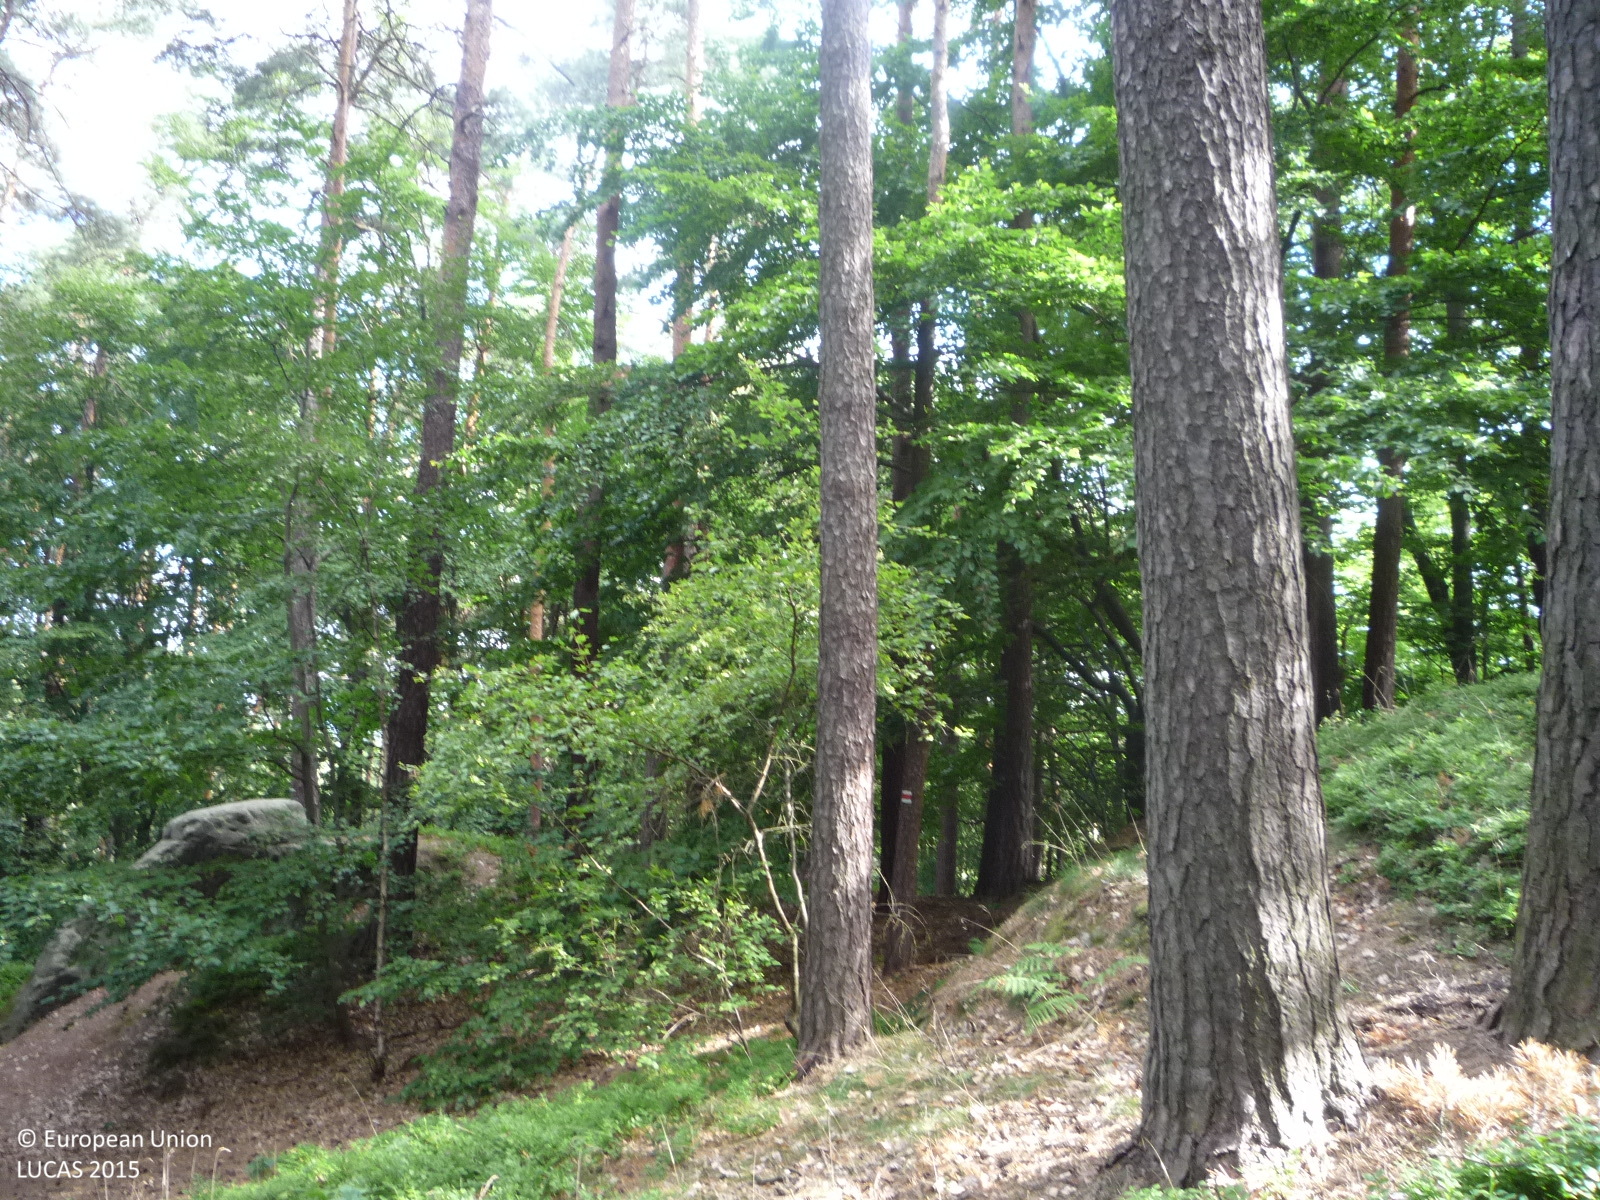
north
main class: Woodland
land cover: Pine dominated mixed woodland
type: hemiboreal forest and nemoral coniferous forest and mixed broadleaved-coniferous forest
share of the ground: > 75 %
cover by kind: coniferous forest trees 60 %, broadleaved forest trees 35 %, herbaceous plants 5 %
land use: Forestry
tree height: > 5 m
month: July
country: CZ
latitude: 50.5086
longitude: 14.5282
